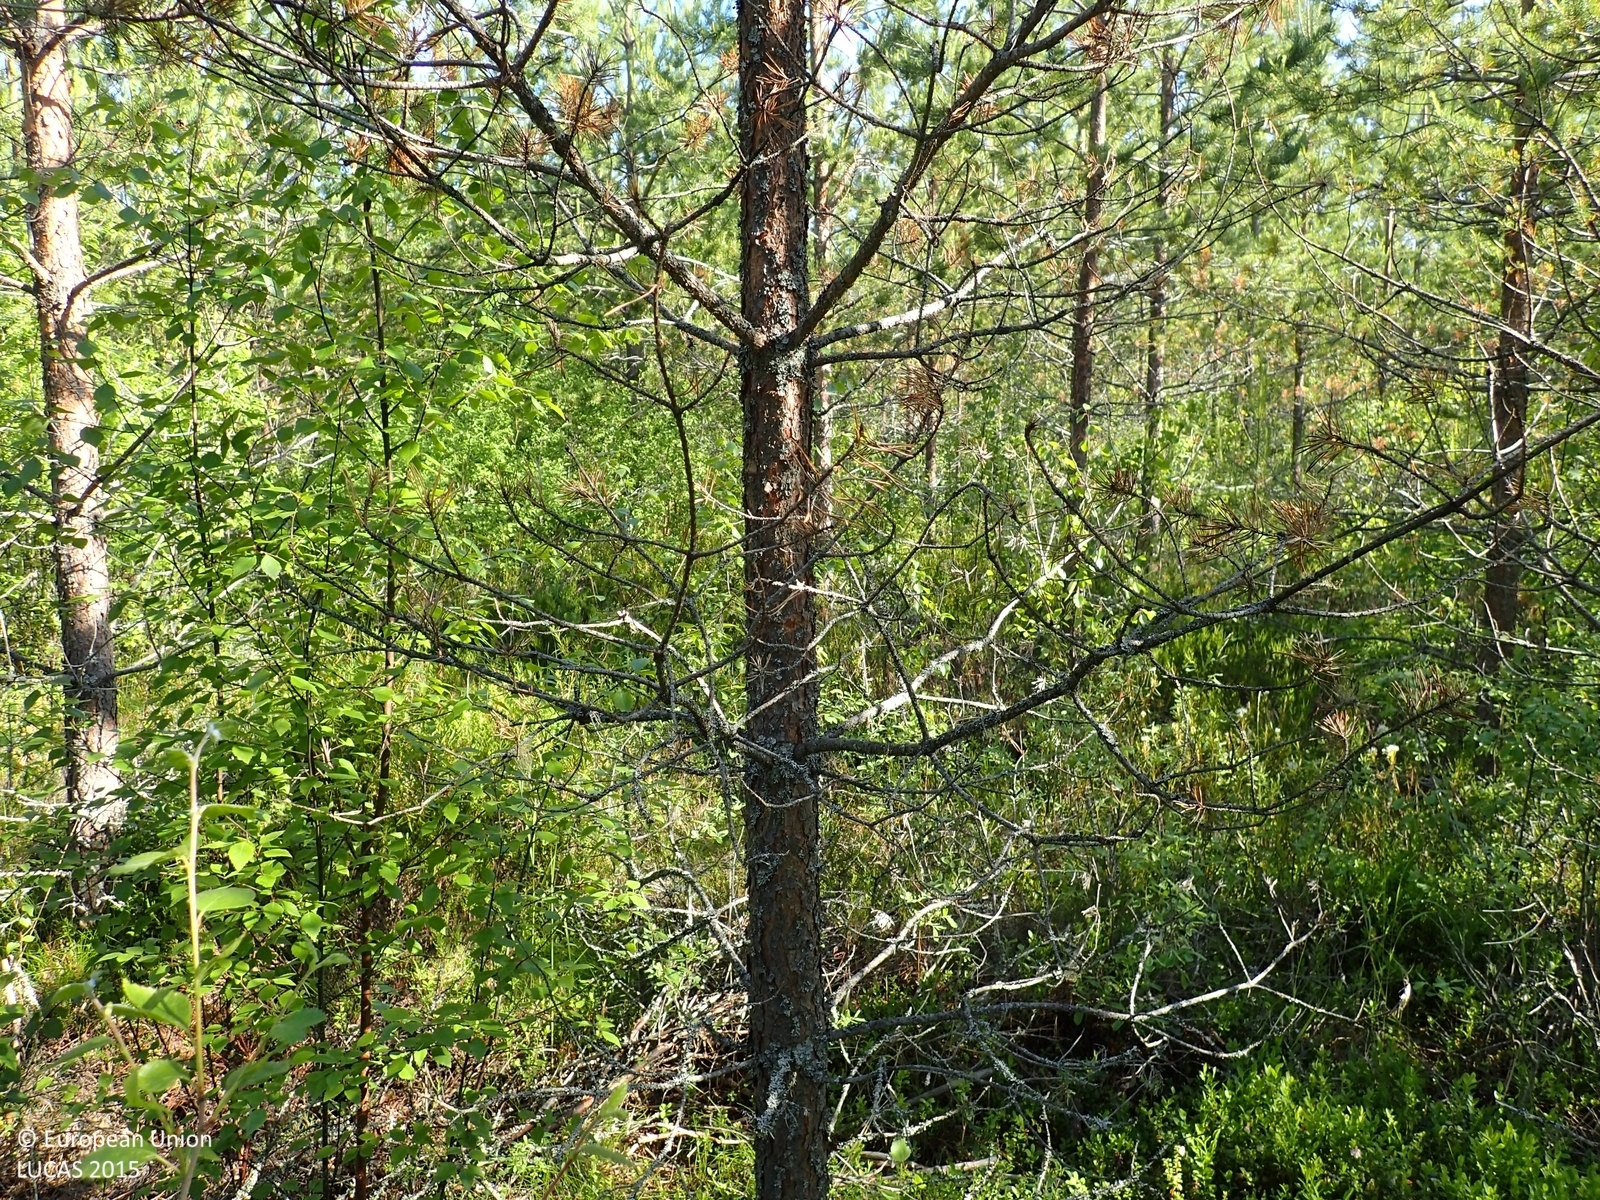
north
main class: Woodland
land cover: Pine dominated mixed woodland
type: boreal forest
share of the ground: 50 - 75 %
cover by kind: coniferous forest trees 50 %, broadleaved forest trees 20 %, shrubs 20 %, herbaceous plants 5 %, lichens and mosses 5 %
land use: Forestry
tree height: < 5 m
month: July
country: FI
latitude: 62.6188
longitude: 21.3647
